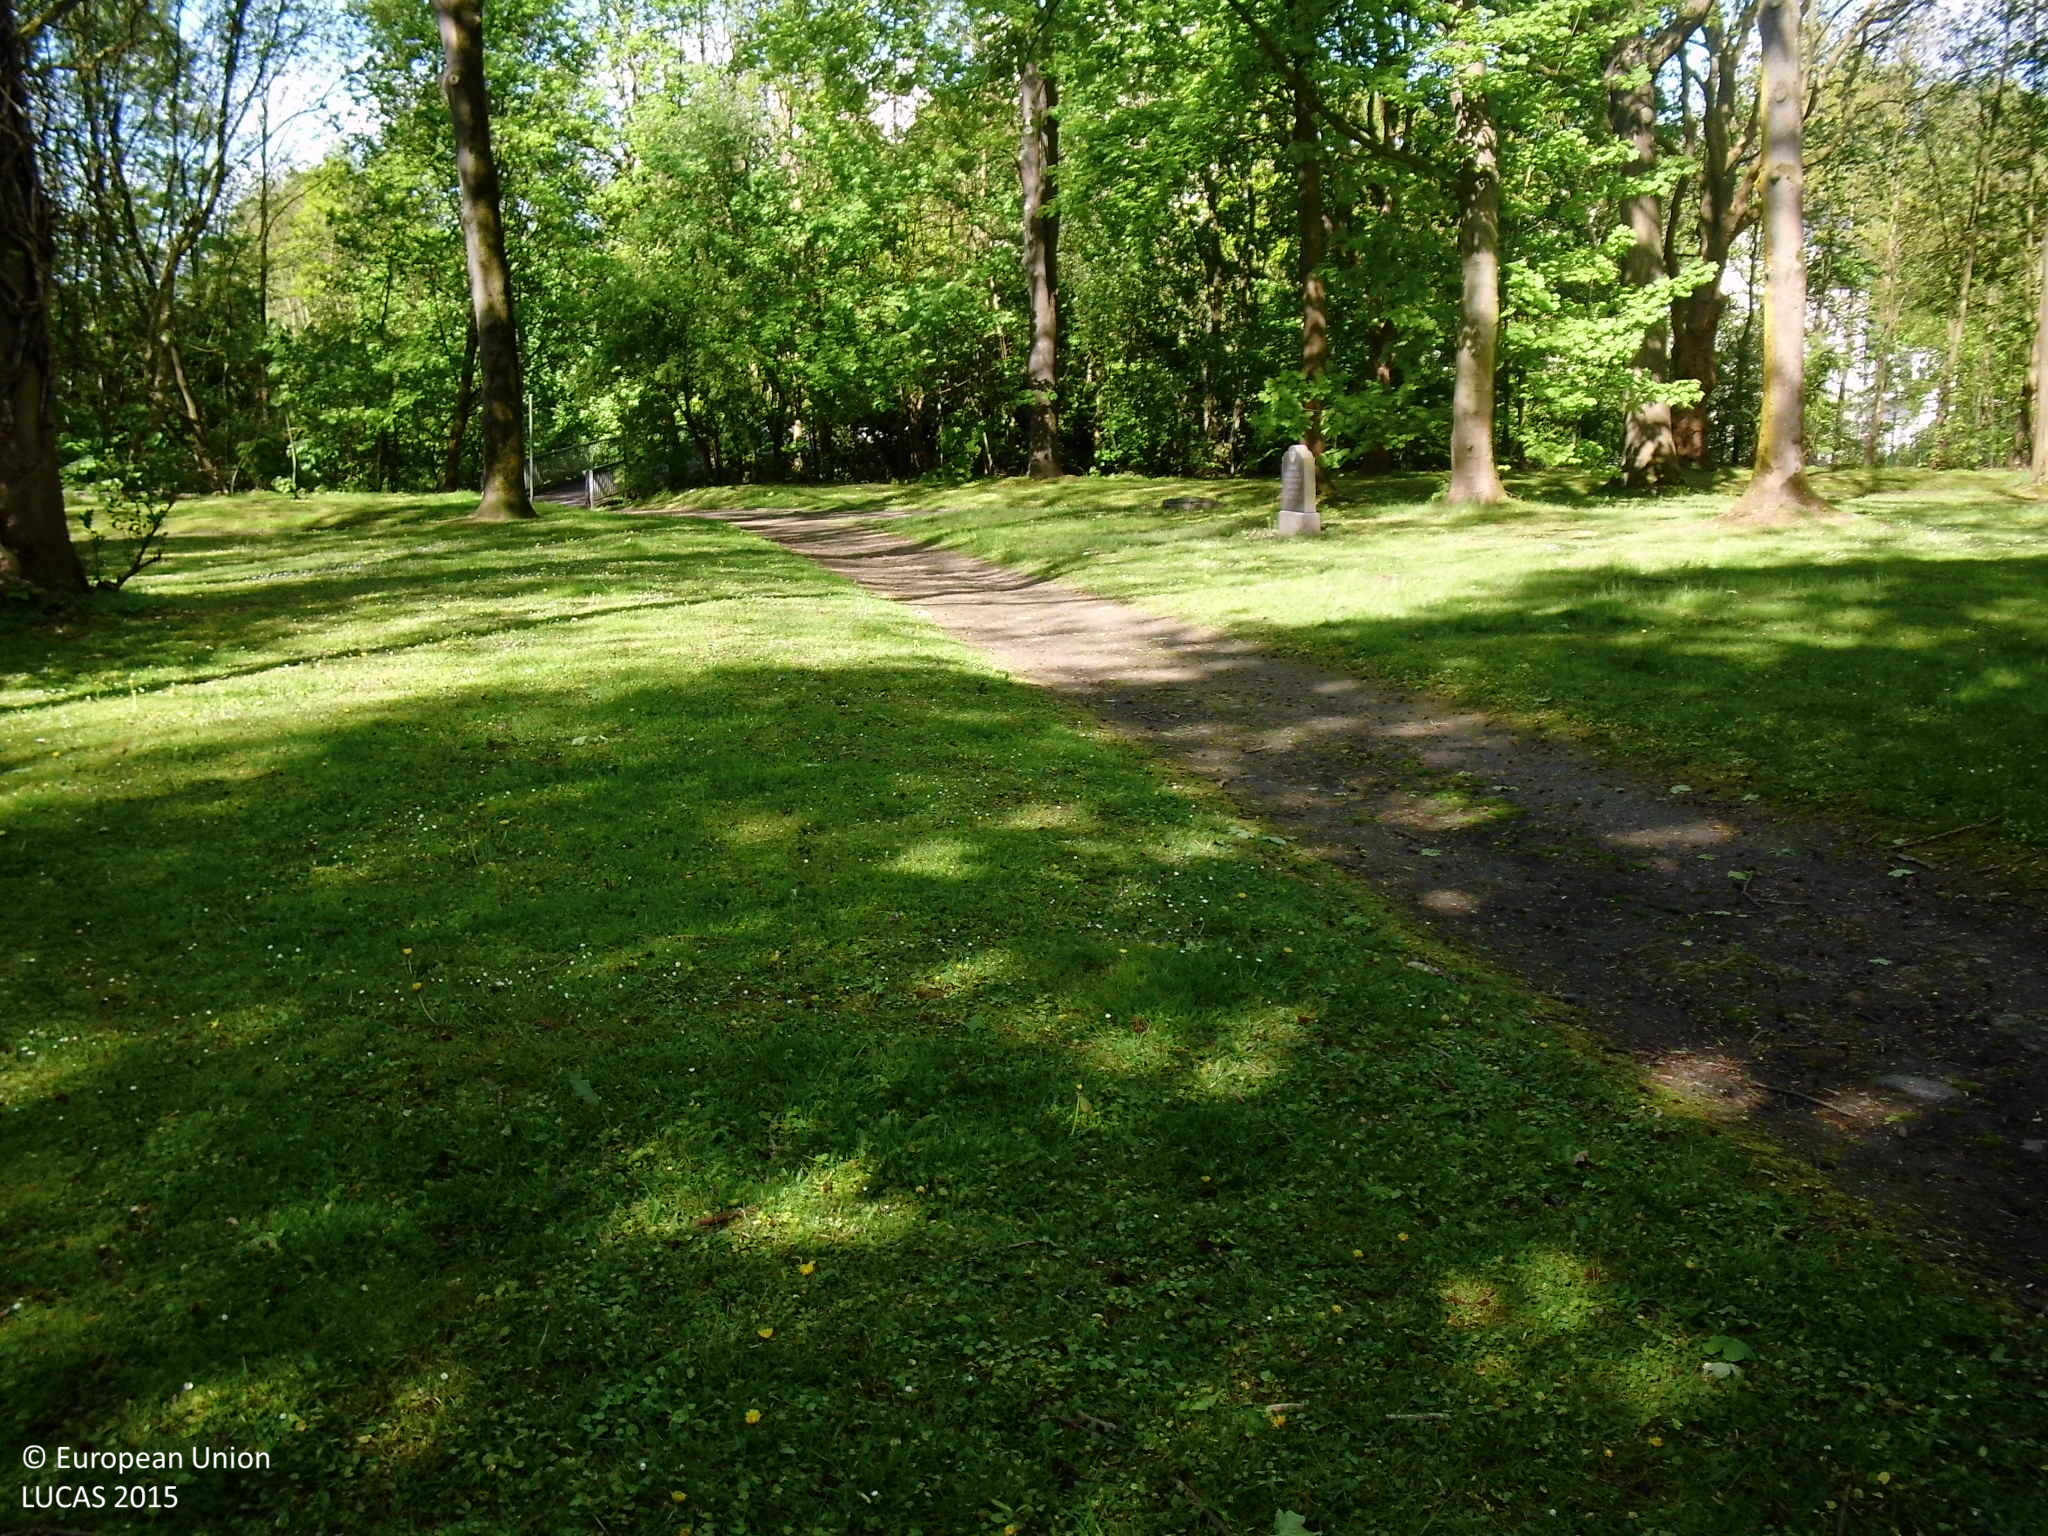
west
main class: Woodland
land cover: Broadleaved woodland
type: mesophytic deciduous forest
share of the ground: > 75 %
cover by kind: broadleaved forest trees 80 %, herbaceous plants 10 %, shrubs 5 %, unconsolidated bare surface 5 %
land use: Community services
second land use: Amenities, museums, leisure
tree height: > 5 m
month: May
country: DE
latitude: 51.5042
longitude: 7.4214
